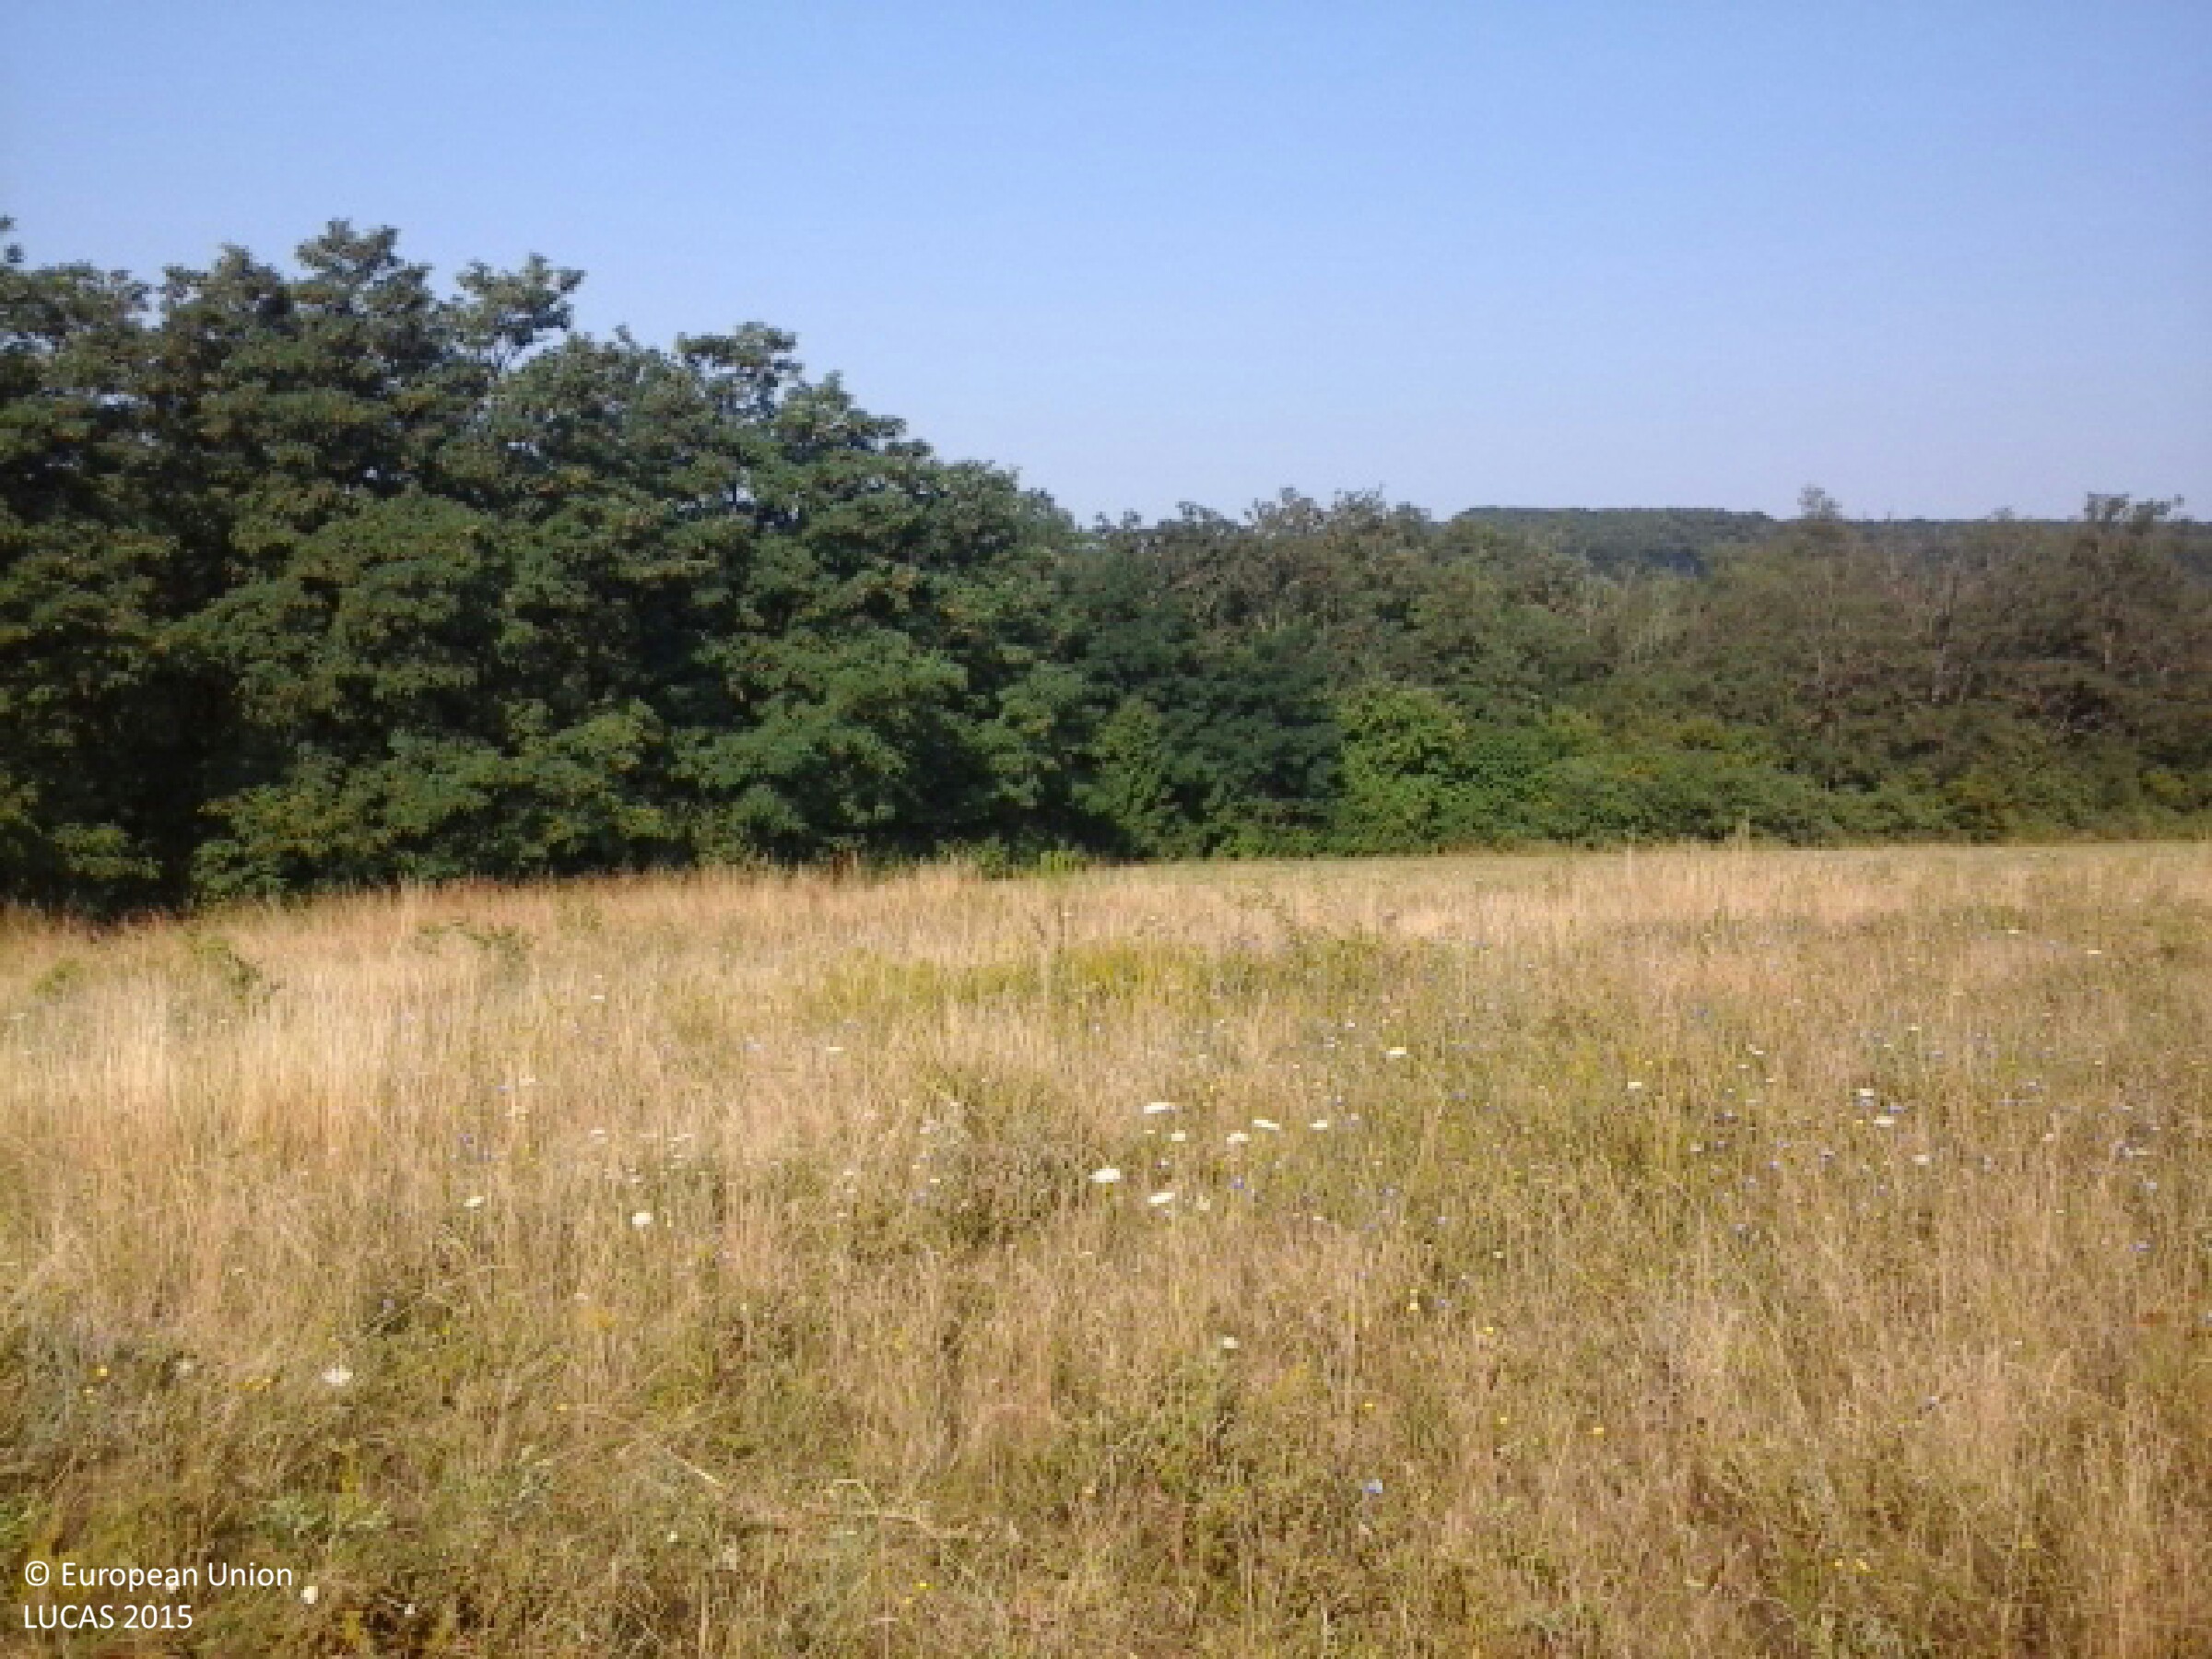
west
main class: Grassland
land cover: Spontaneously vegetated surfaces
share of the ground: > 75 %
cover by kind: herbaceous plants 100 %
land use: Fallow land
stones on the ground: < 10 %
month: July
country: HU
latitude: 48.4186
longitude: 20.9713
